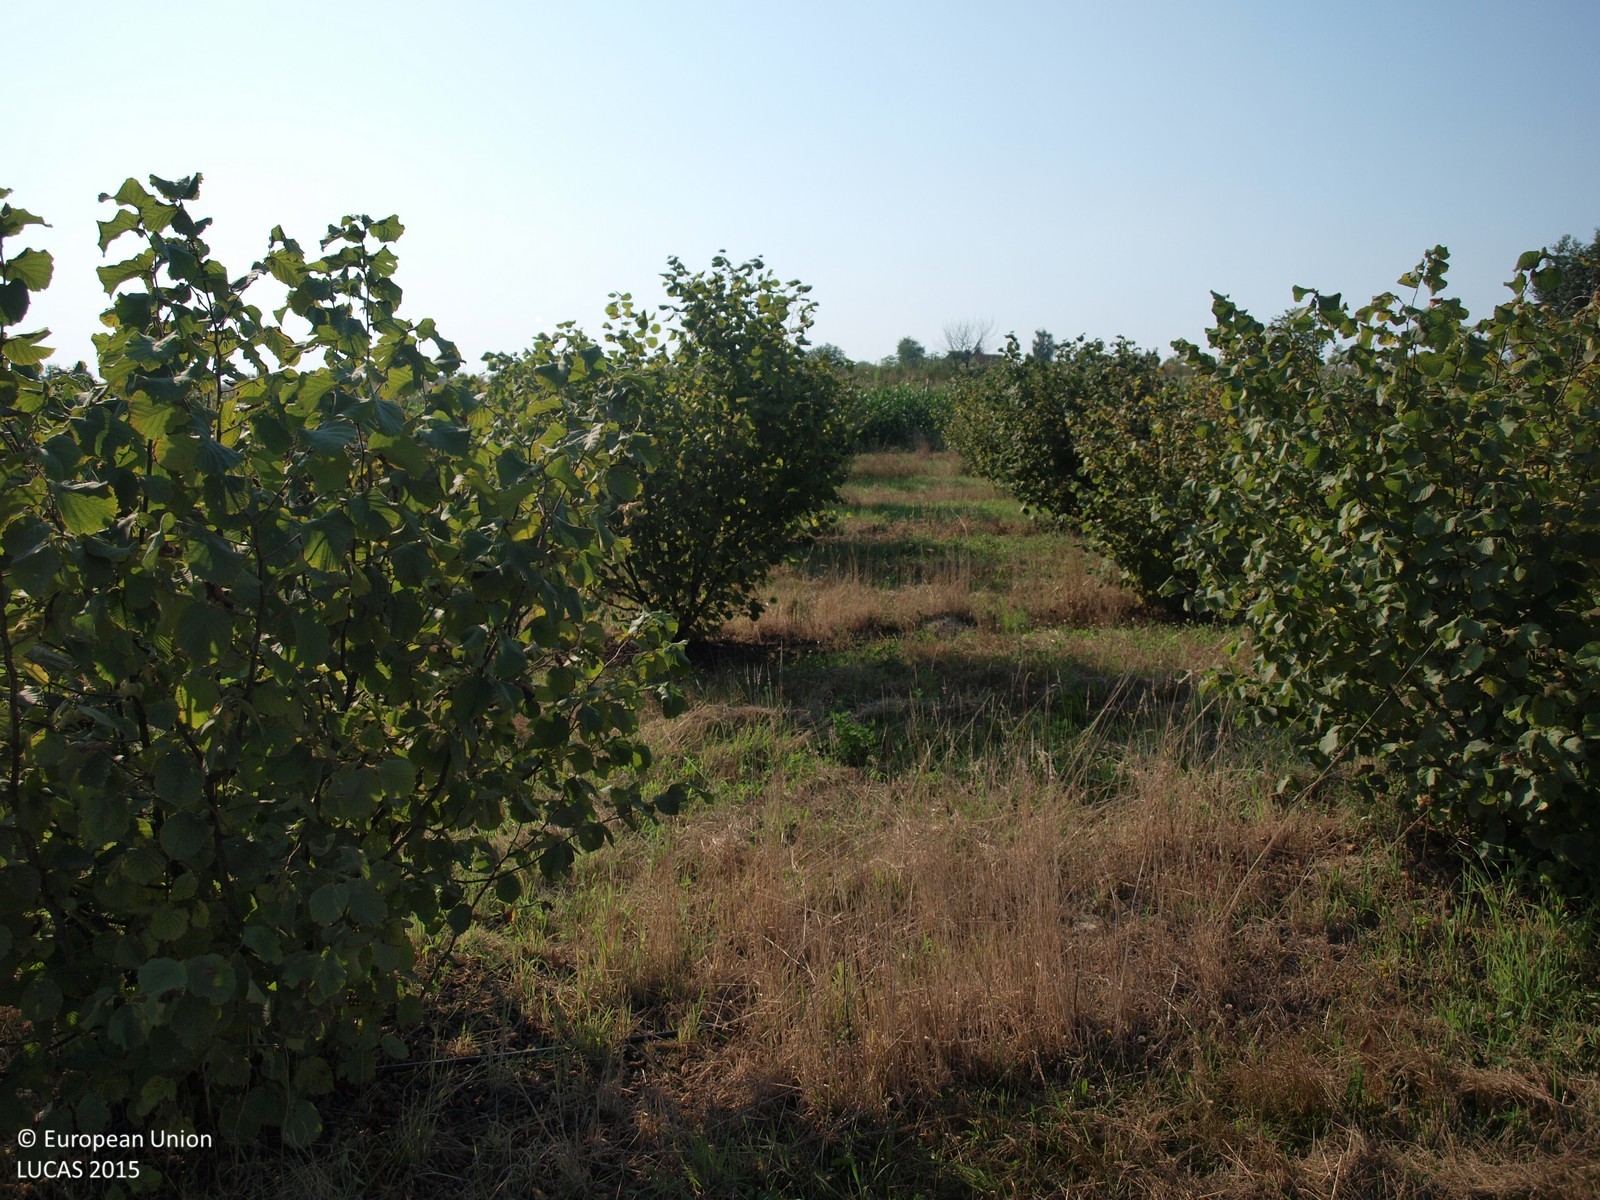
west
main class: Cropland
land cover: Nuts trees
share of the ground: 25 - 50 %
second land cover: Grassland without tree/shrub cover
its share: > 75 %
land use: Agriculture (excluding fallow land and kitchen gardens)
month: August
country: HR
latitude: 45.8414
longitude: 16.5789
